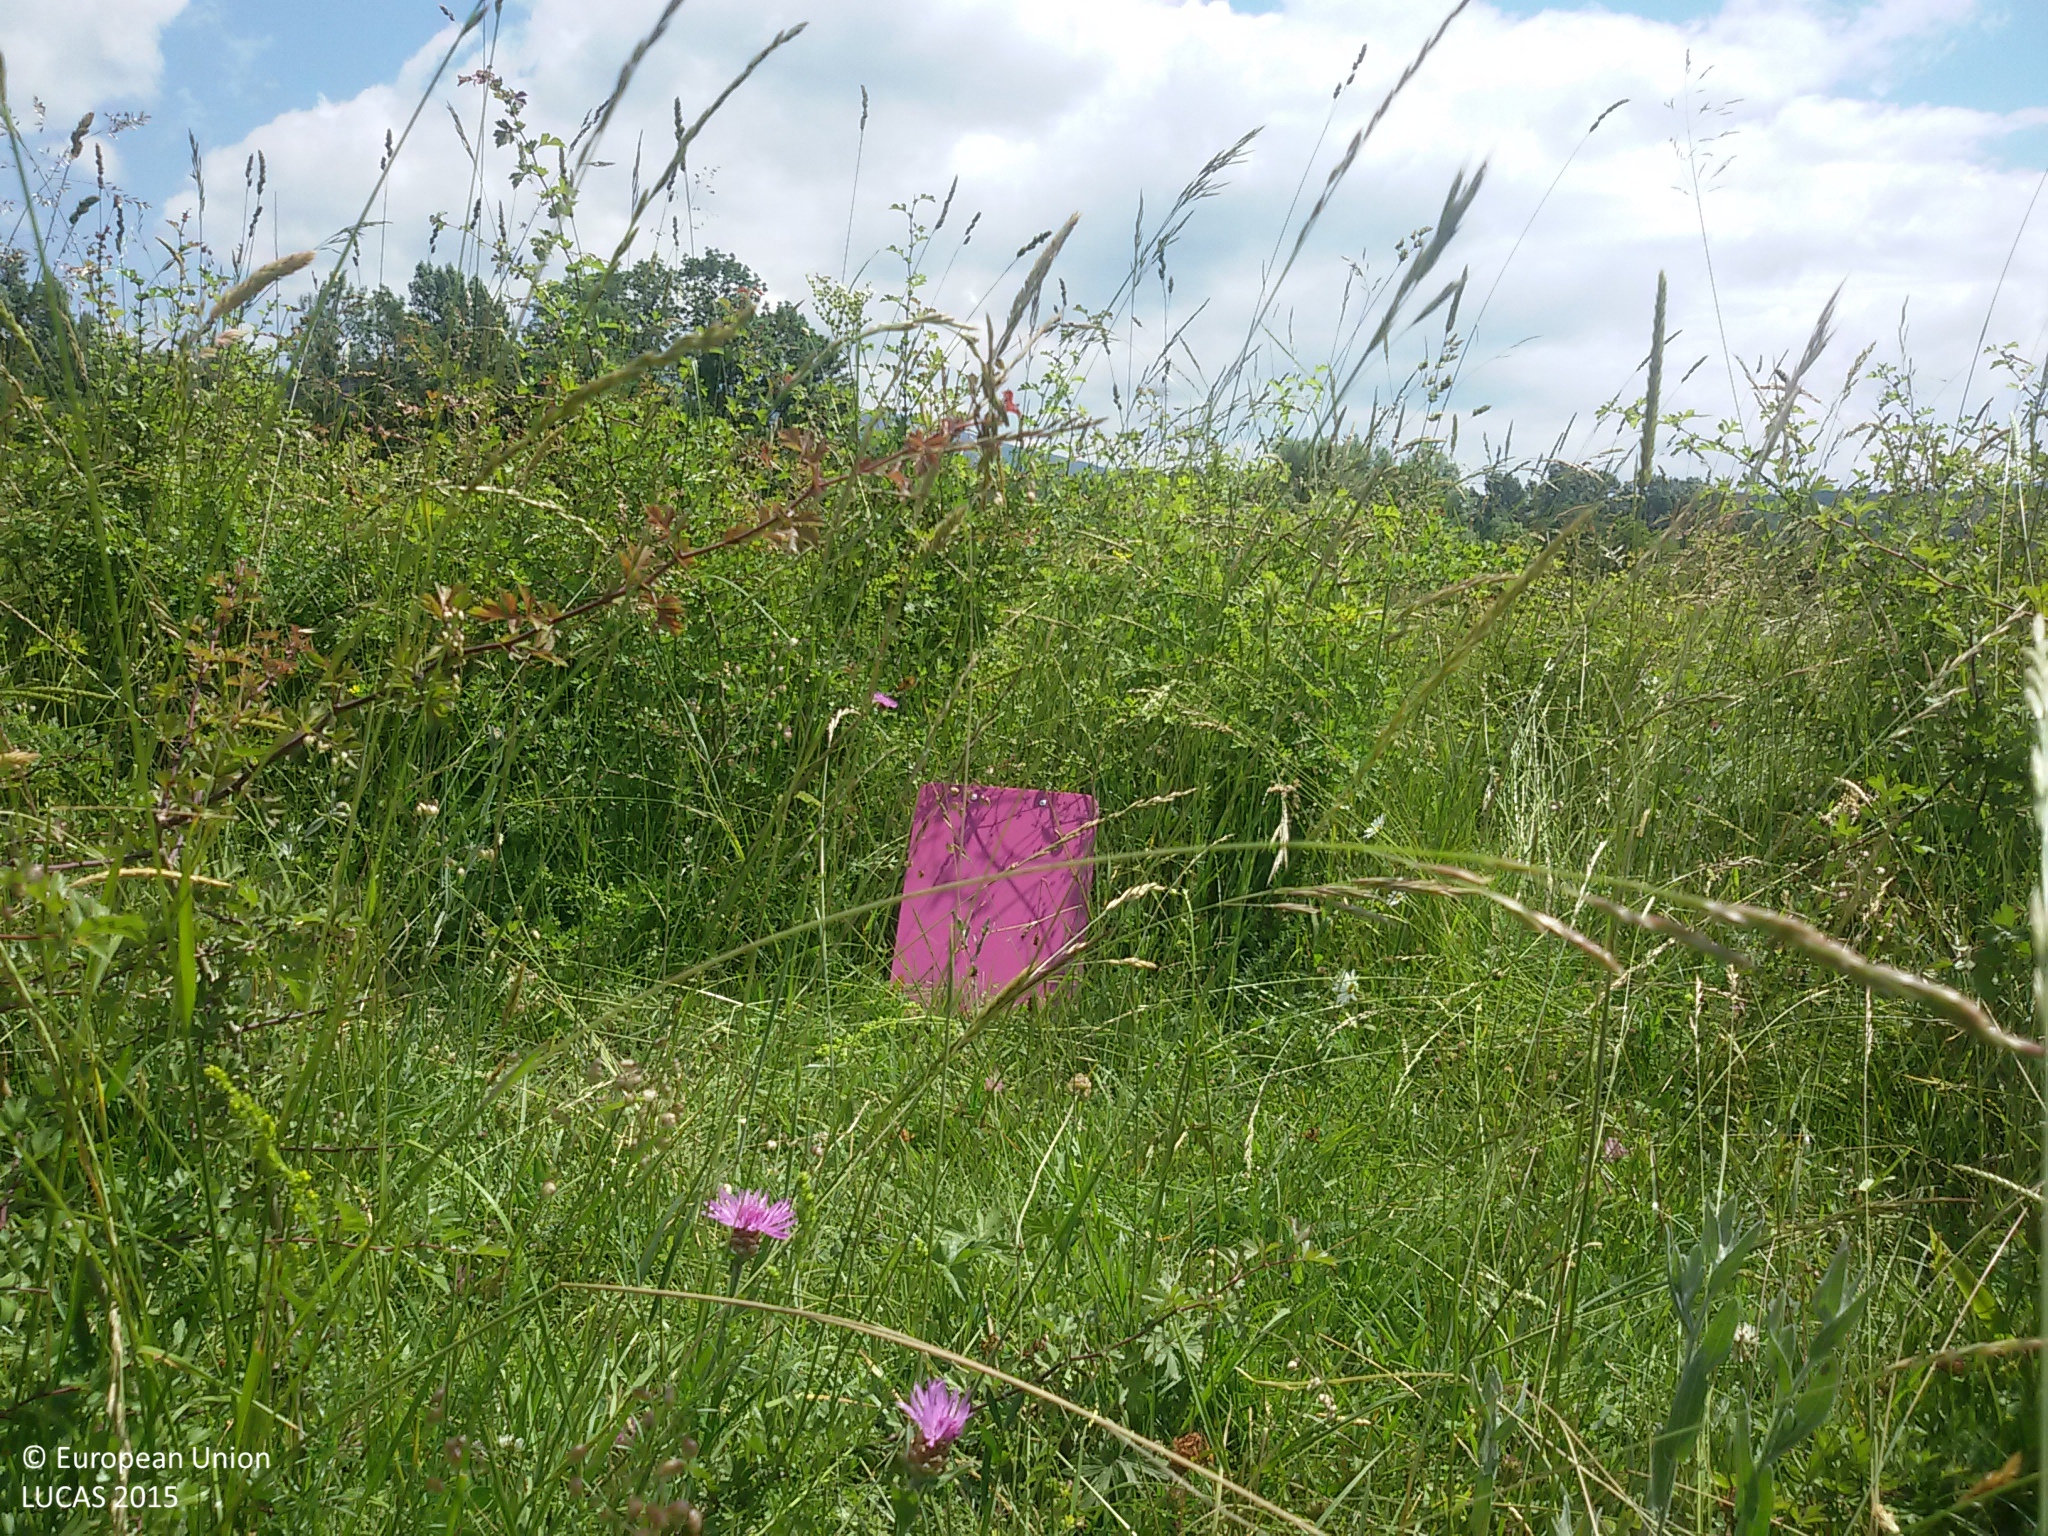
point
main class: Grassland
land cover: Grassland without tree/shrub cover
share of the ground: > 75 %
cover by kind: herbaceous plants 90 %, shrubs 5 %, unconsolidated bare surface 5 %
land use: Agriculture (excluding fallow land and kitchen gardens)
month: June
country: HR
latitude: 44.5155
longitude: 15.7680
